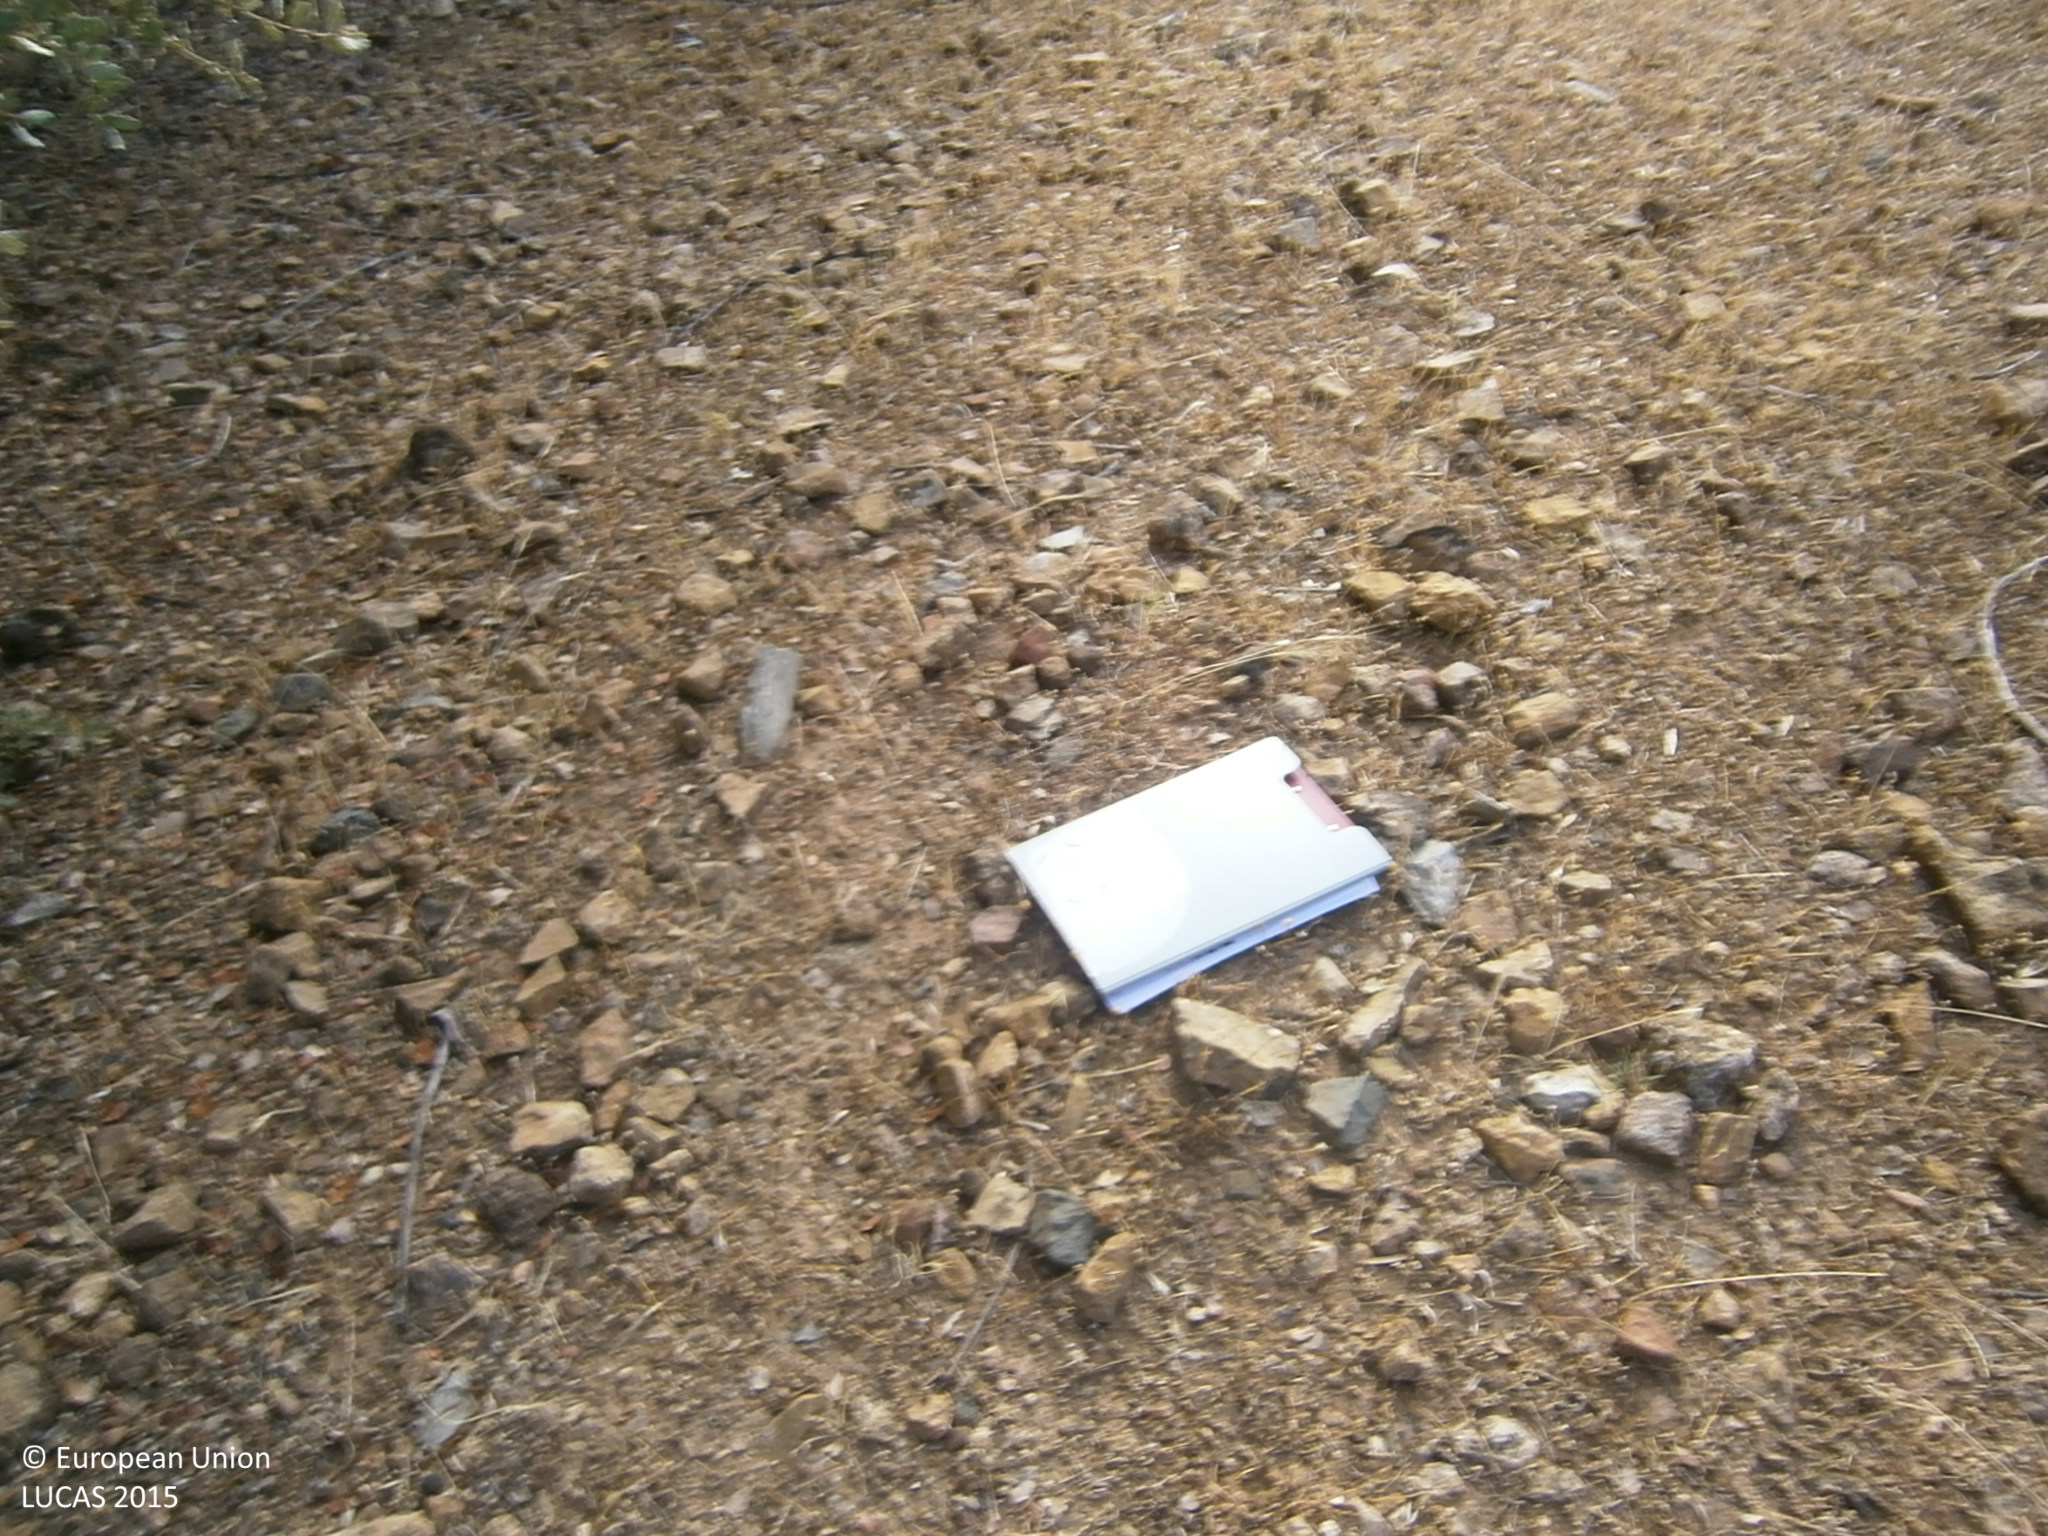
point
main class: Cropland
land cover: Olive groves
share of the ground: 10 - 25 %
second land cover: Spontaneously vegetated surfaces
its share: 50 - 75 %
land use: Agriculture (excluding fallow land and kitchen gardens)
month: June
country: ES
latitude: 38.6368
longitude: -6.8235
